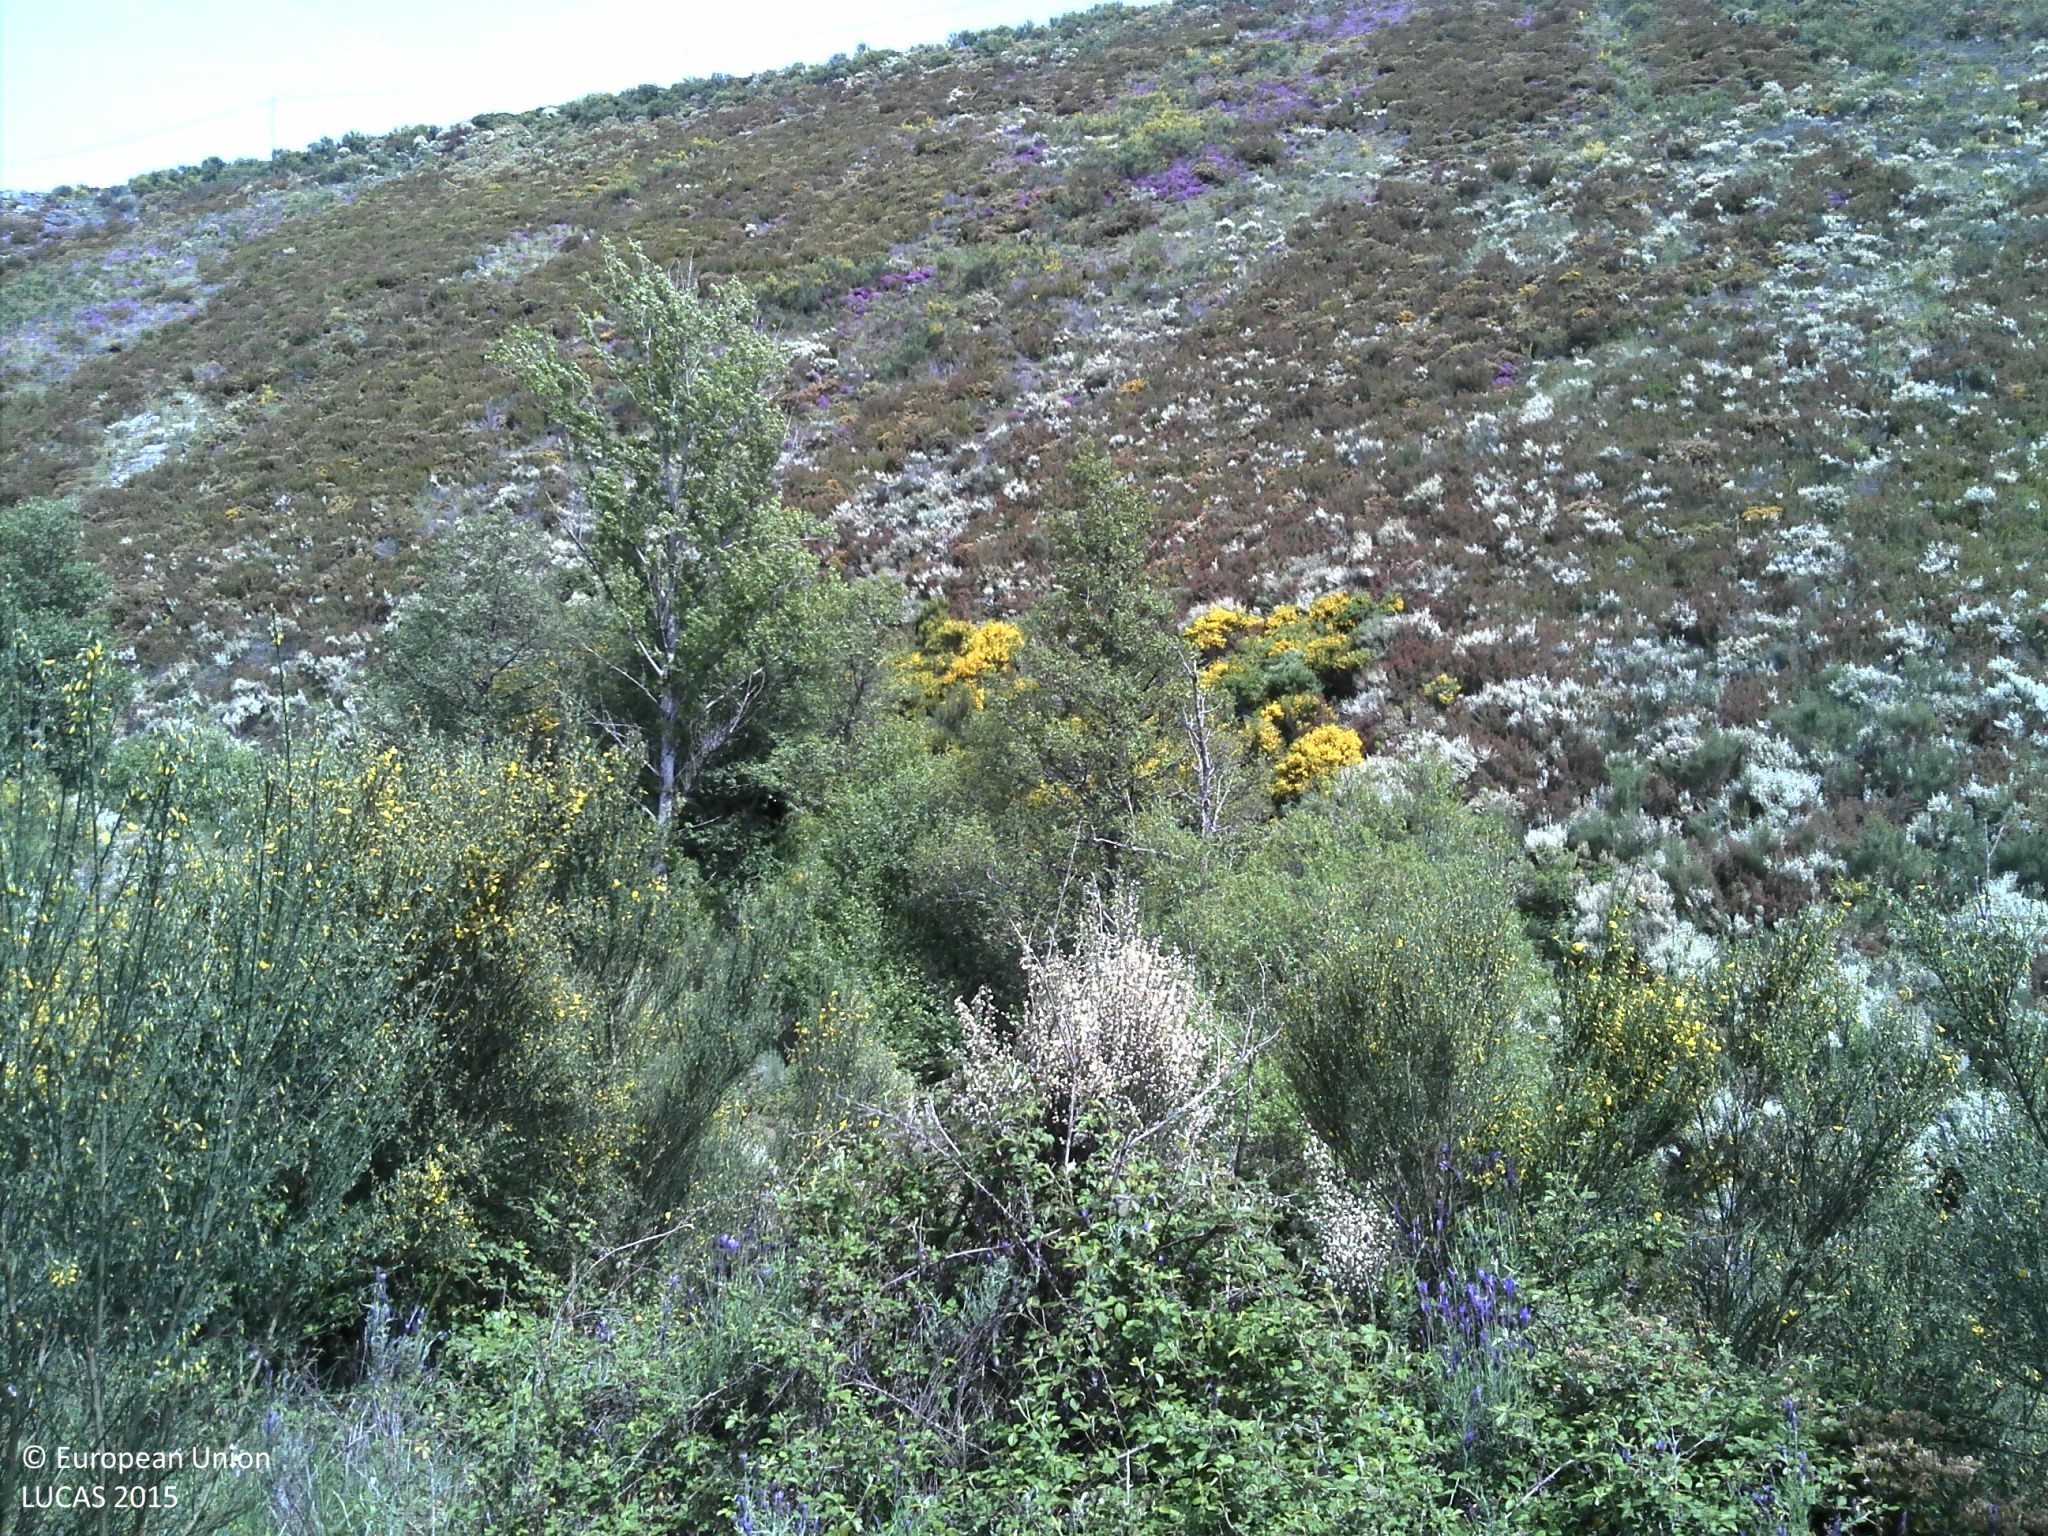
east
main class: Shrubland
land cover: Shrubland without tree cover
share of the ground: 25 - 50 %
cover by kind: shrubs 50 %, unconsolidated bare surface 40 %, herbaceous plants 10 %
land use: Semi-natural and natural areas not in use
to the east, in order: Shrubland without tree cover; Abandoned hedges; Rivers and streams; Abandoned hedges; Shrubland without tree cover; Grass margins; Paved roads, cycling and walking lanes; Grass margins; Ditches and canals; Shrubland without tree cover; Electric lines; Shrubland without tree cover
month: May
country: PT
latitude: 41.9257
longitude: -7.0898
